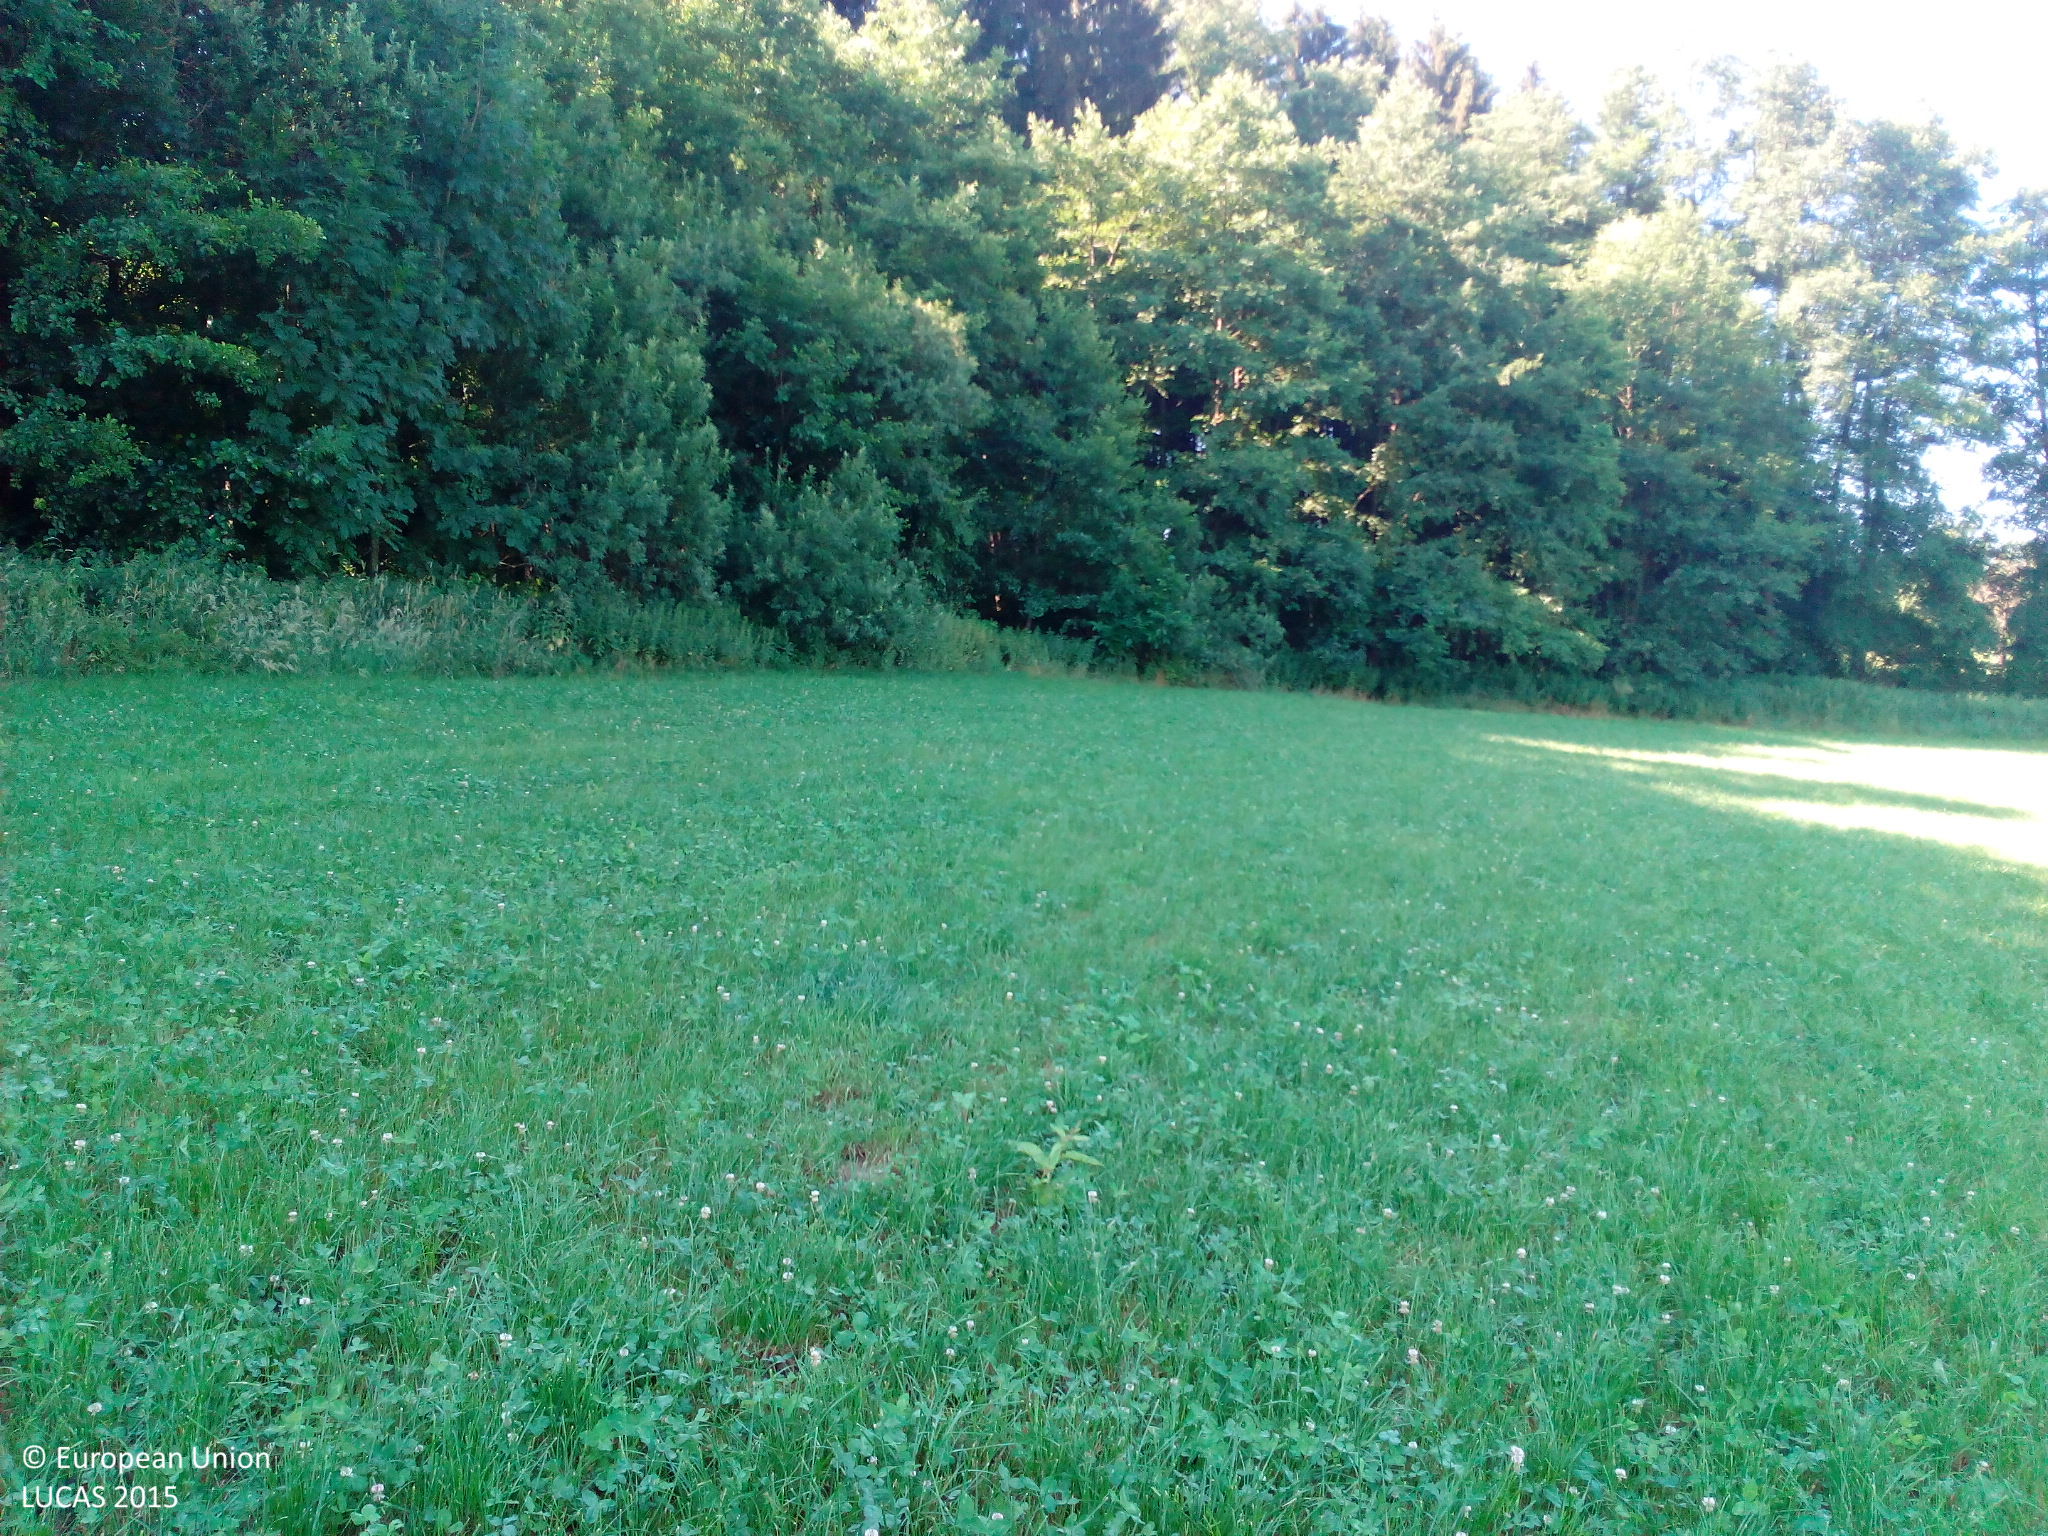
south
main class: Cropland
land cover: Temporary grasslands
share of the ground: 50 - 75 %
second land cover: Clovers
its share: 25 - 50 %
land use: Agriculture (excluding fallow land and kitchen gardens)
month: July
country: DE
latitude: 47.7910
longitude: 9.6399
